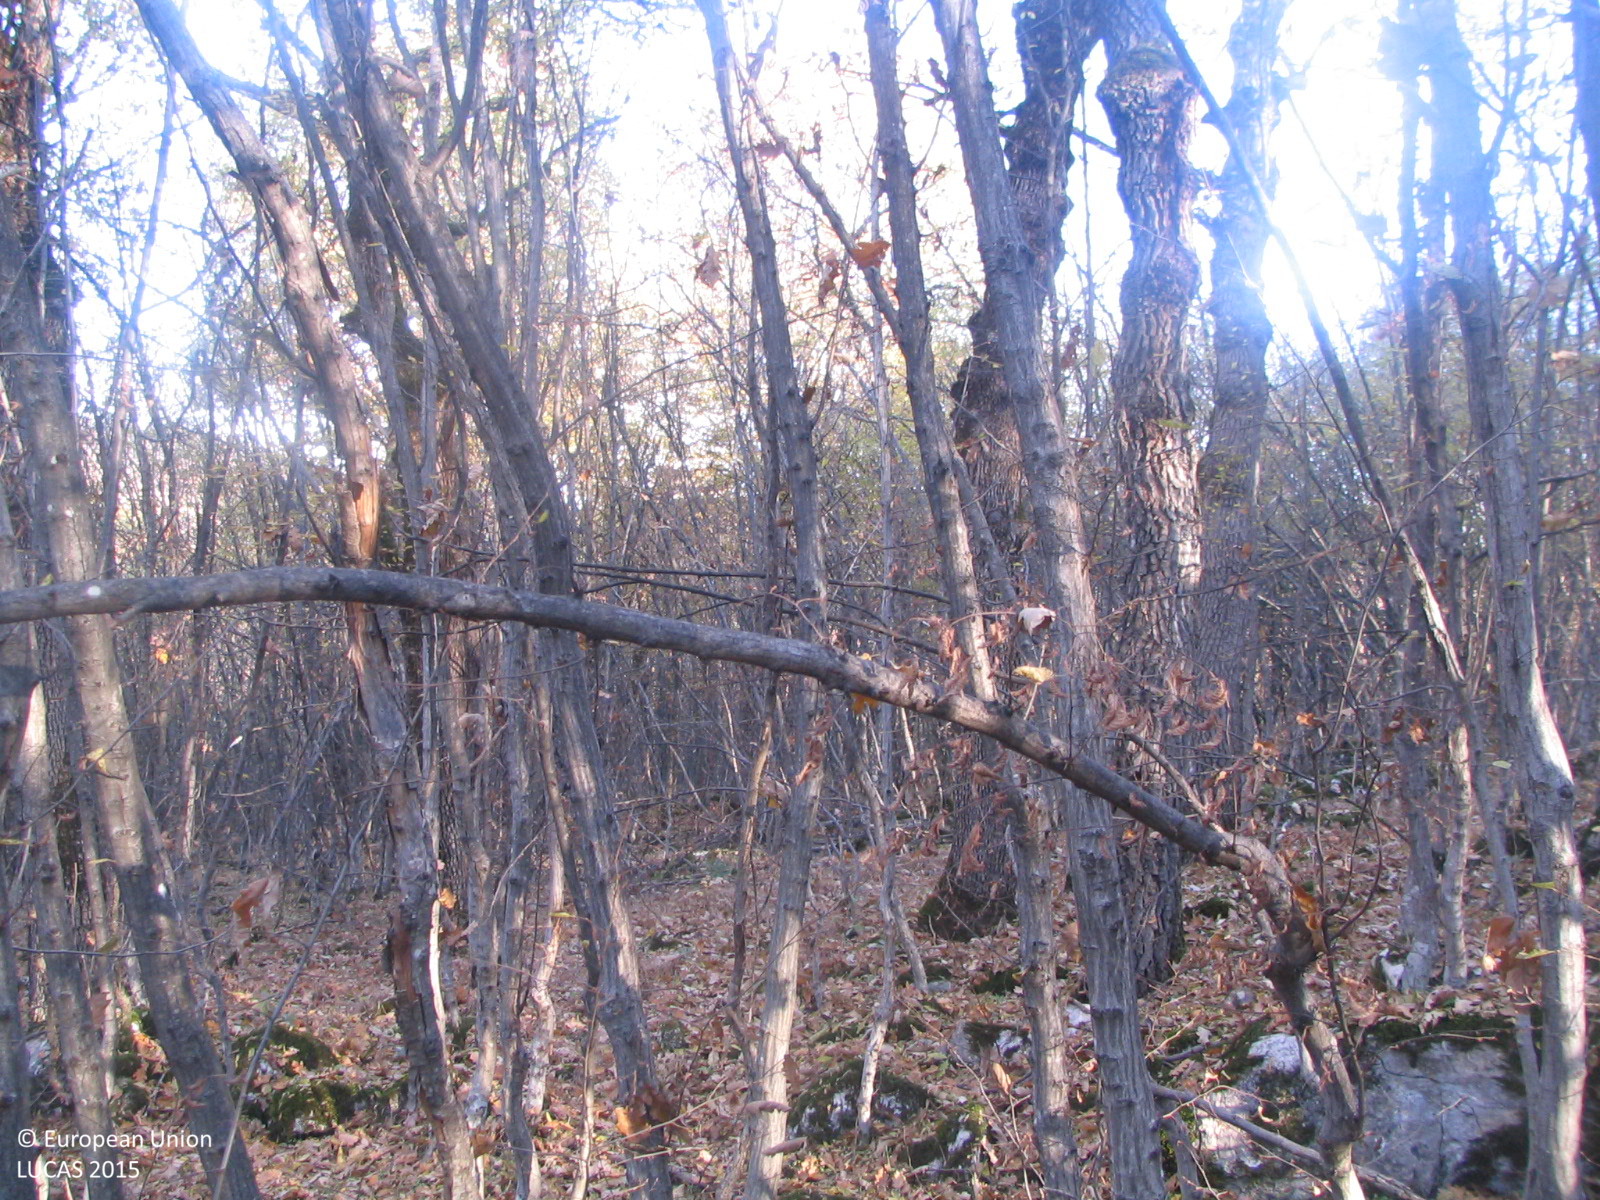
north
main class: Woodland
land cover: Broadleaved woodland
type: acidophilous oak and oak-birch forest
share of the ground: > 75 %
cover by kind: broadleaved forest trees 90 %, shrubs 5 %, herbaceous plants 5 %
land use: Forestry
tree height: > 5 m
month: November
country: BG
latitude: 43.0067
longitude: 23.7722
